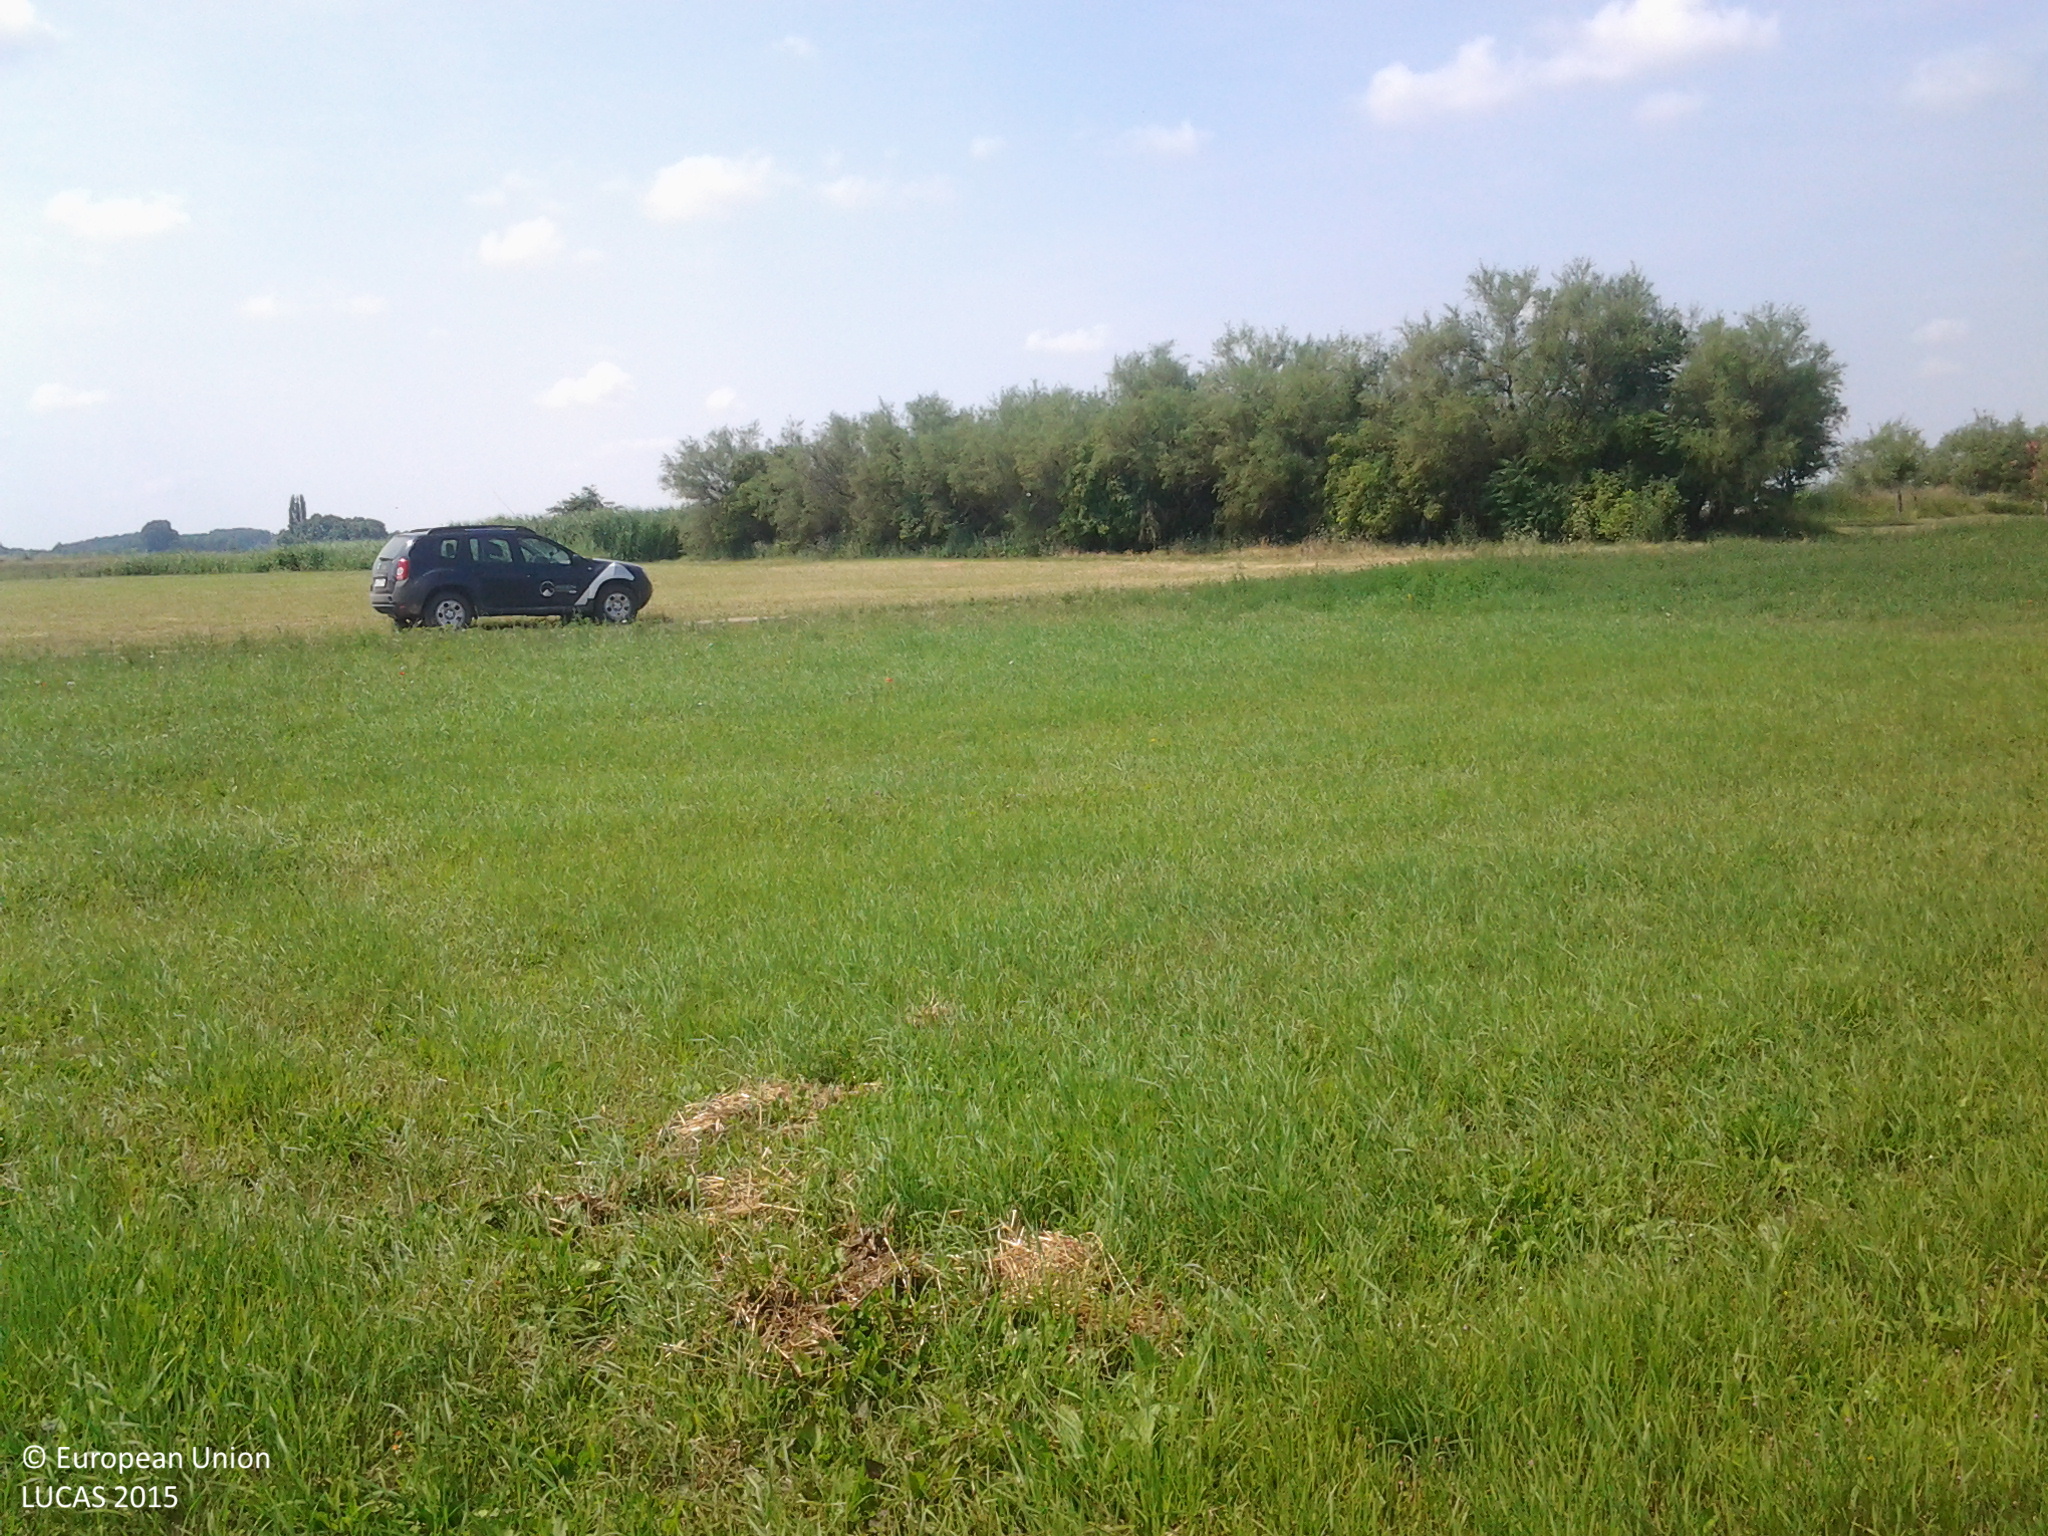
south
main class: Grassland
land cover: Grassland without tree/shrub cover
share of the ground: > 75 %
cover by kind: herbaceous plants 100 %
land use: Agriculture (excluding fallow land and kitchen gardens)
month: June
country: HU
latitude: 46.7631
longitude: 19.2738
